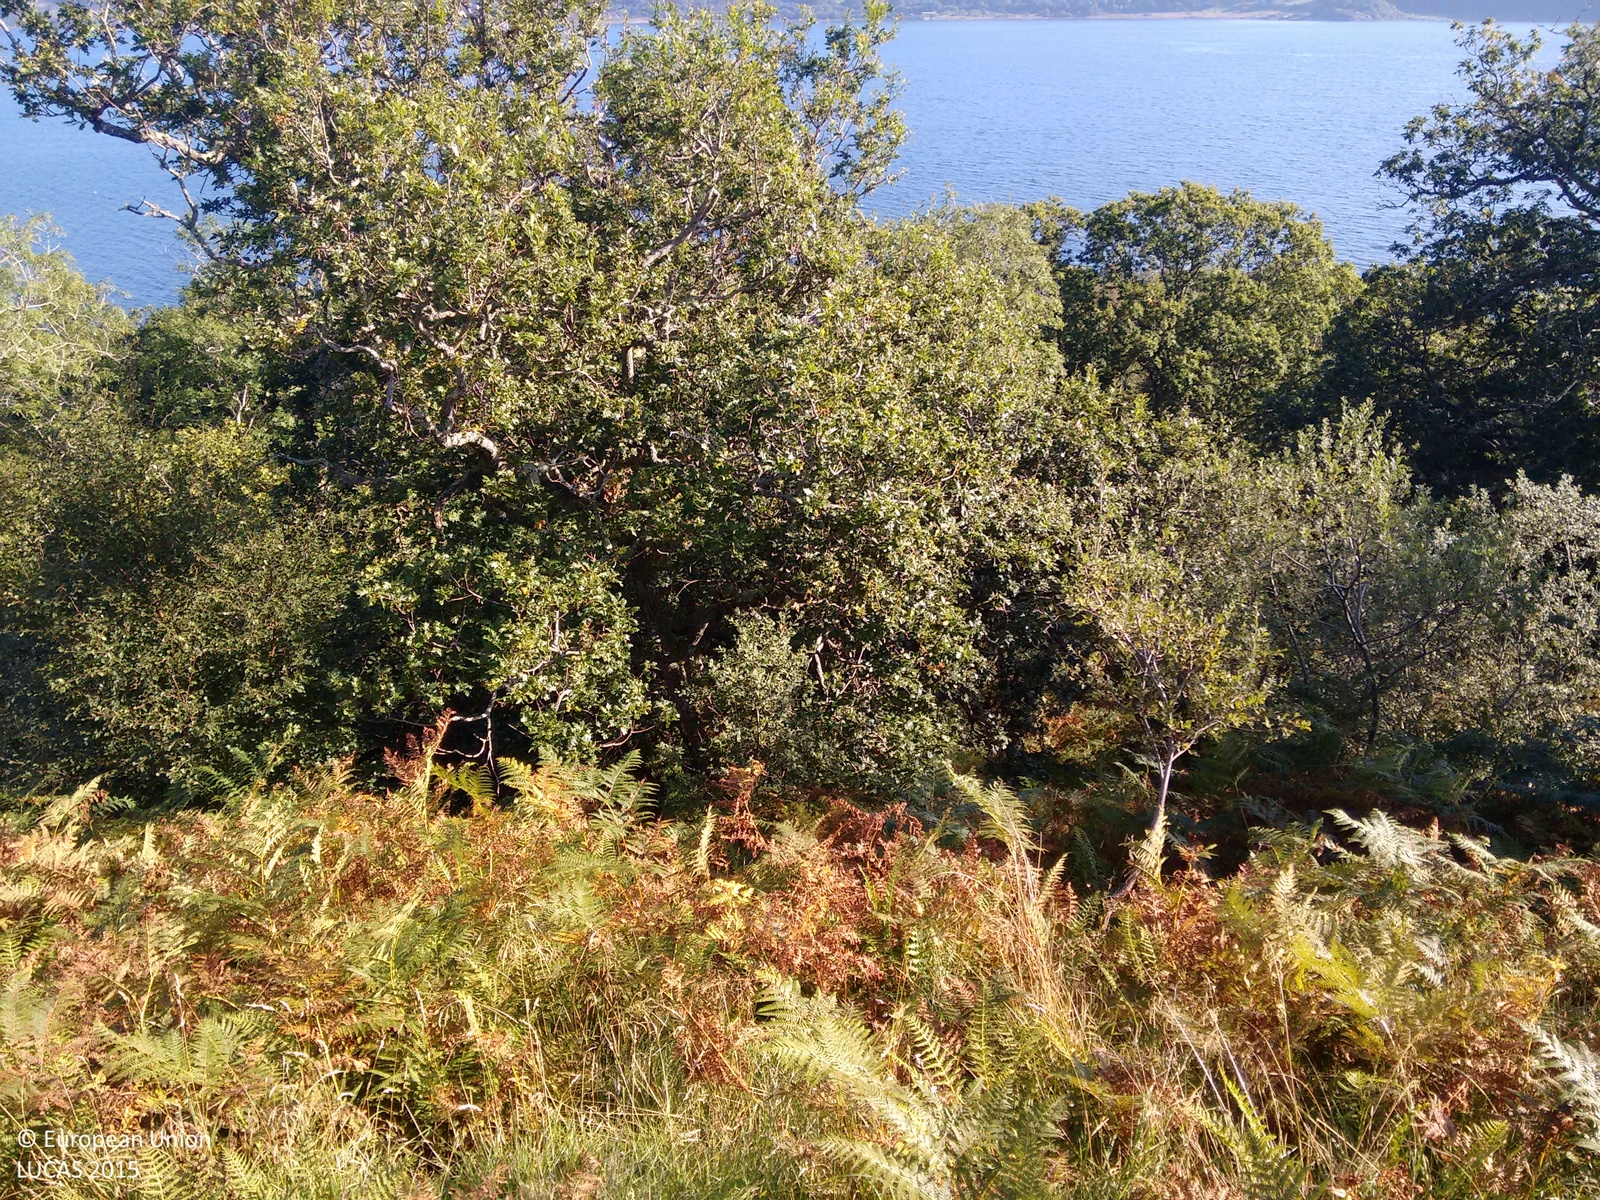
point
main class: Woodland
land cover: Broadleaved woodland
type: non-riverine alder, birch or aspen forest
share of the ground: > 75 %
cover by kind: broadleaved forest trees 95 %, shrubs 5 %
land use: Semi-natural and natural areas not in use
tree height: > 5 m
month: August
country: GB
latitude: 56.2565
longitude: -5.5710
